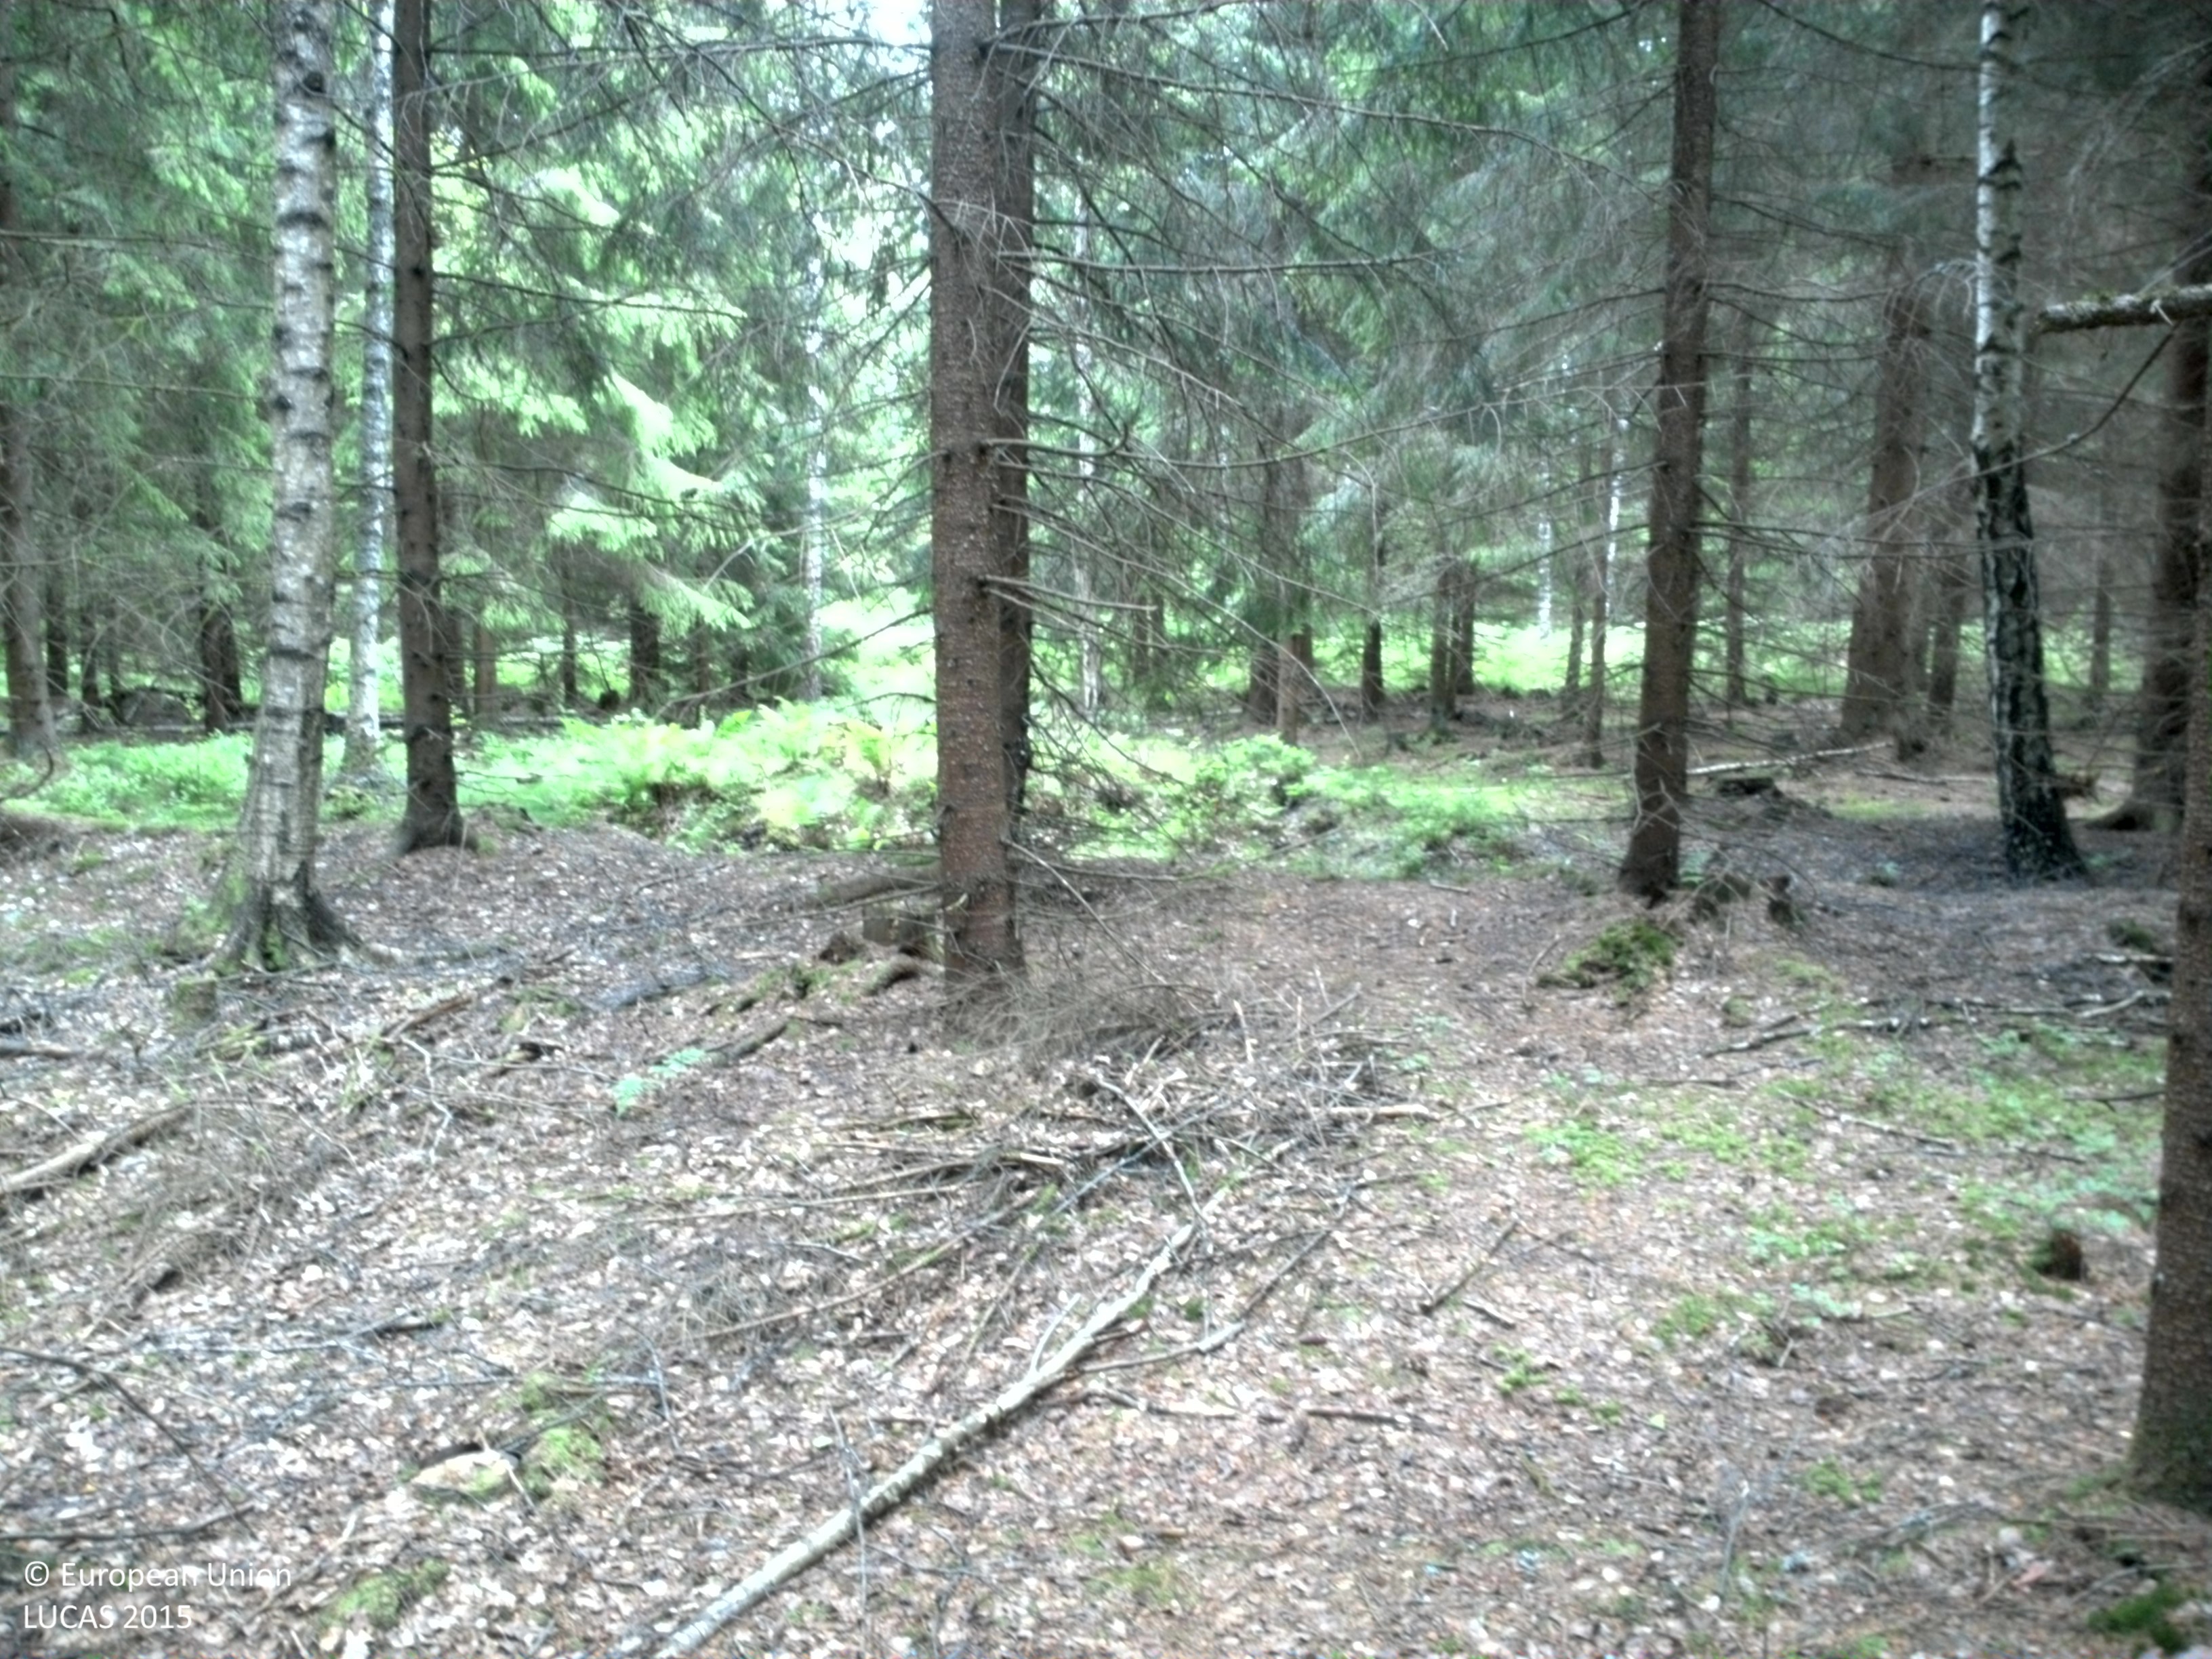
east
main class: Woodland
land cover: Spruce dominated coniferous woodland
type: boreal forest
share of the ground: 50 - 75 %
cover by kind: coniferous forest trees 70 %, herbaceous plants 10 %, consolidated bare surface 10 %, broadleaved forest trees 5 %, lichens and mosses 5 %
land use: Forestry
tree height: > 5 m
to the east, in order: Spruce dominated coniferous woodland; Ditches and canals; Spruce dominated coniferous woodland; Tracks; Broadleaved woodland; Rock outcrops; Broadleaved woodland; Tracks; Broadleaved woodland; Pine dominated mixed woodland; Tracks; Pine dominated mixed woodland; Inland marshes; Inland fresh water bodies
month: June
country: SE
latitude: 58.5629
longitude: 15.3743
